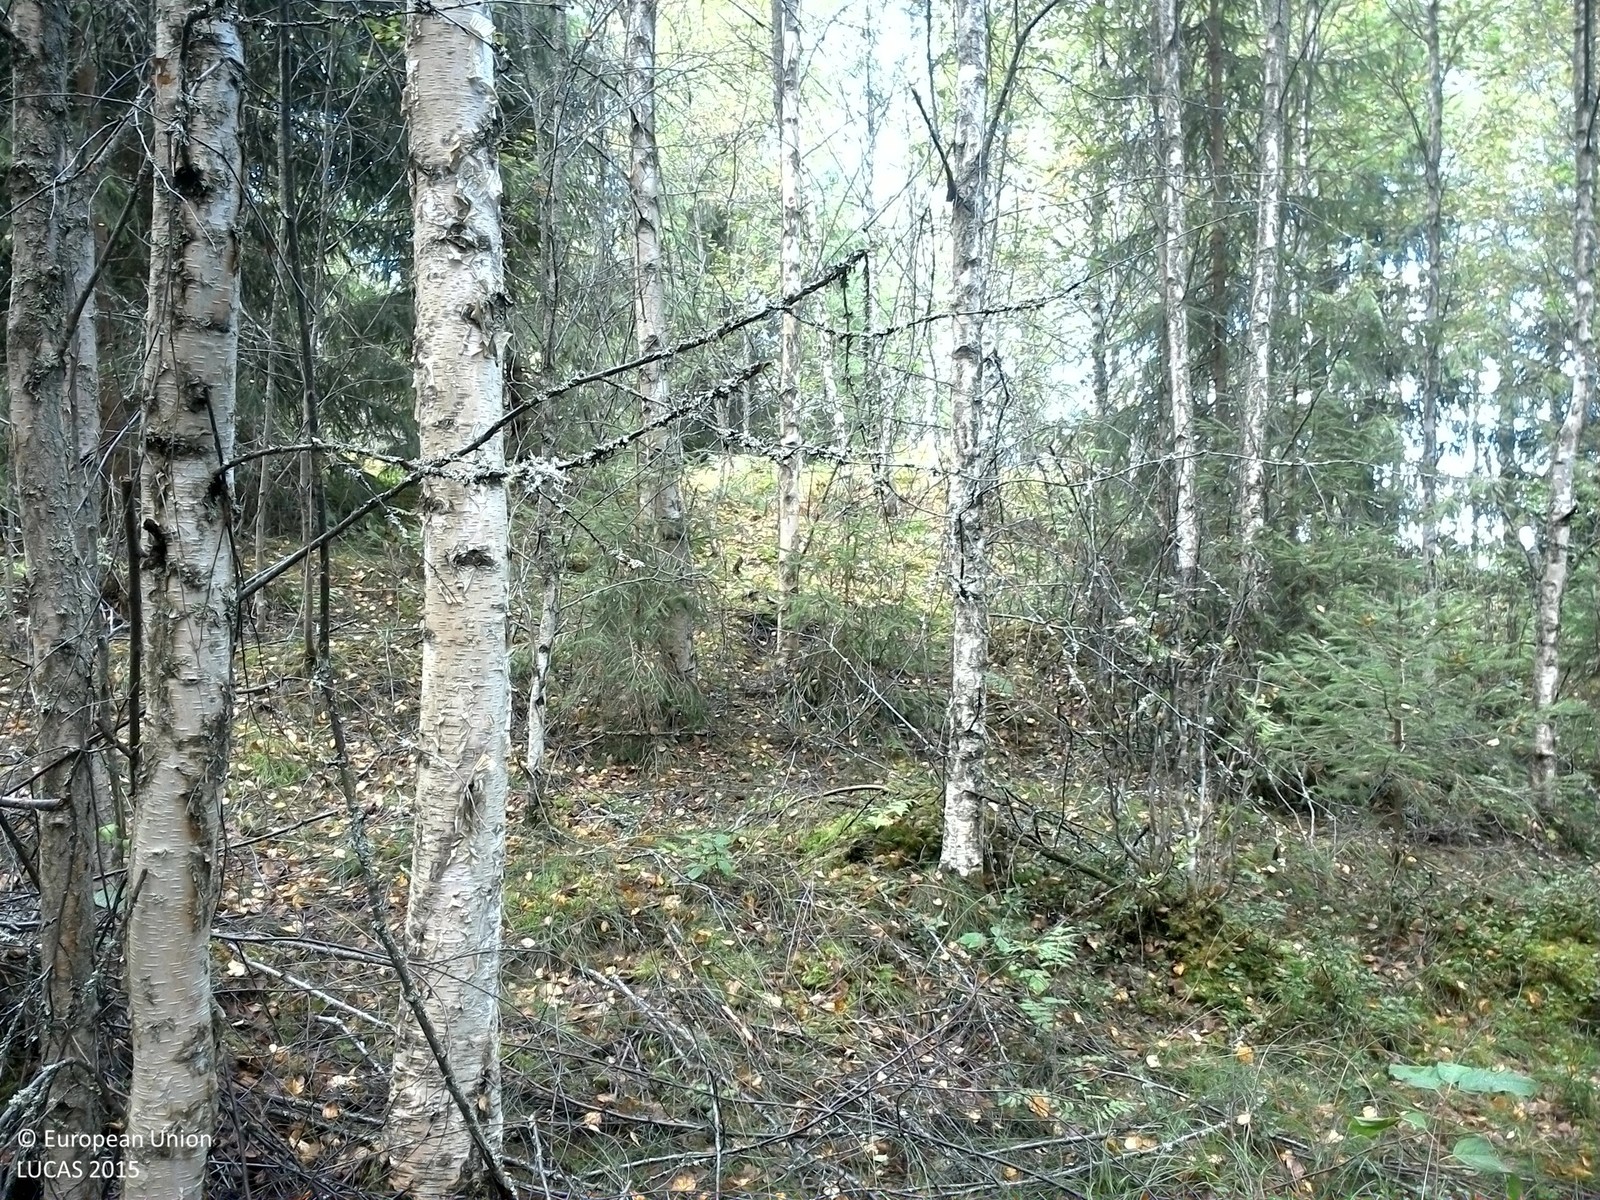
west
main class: Woodland
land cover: Spruce dominated mixed woodland
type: boreal forest
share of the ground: 50 - 75 %
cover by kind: coniferous forest trees 45 %, broadleaved forest trees 30 %, herbaceous plants 15 %, lichens and mosses 10 %
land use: Forestry
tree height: > 5 m
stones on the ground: < 10 %
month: September
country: SE
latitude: 59.7665
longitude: 13.1789
